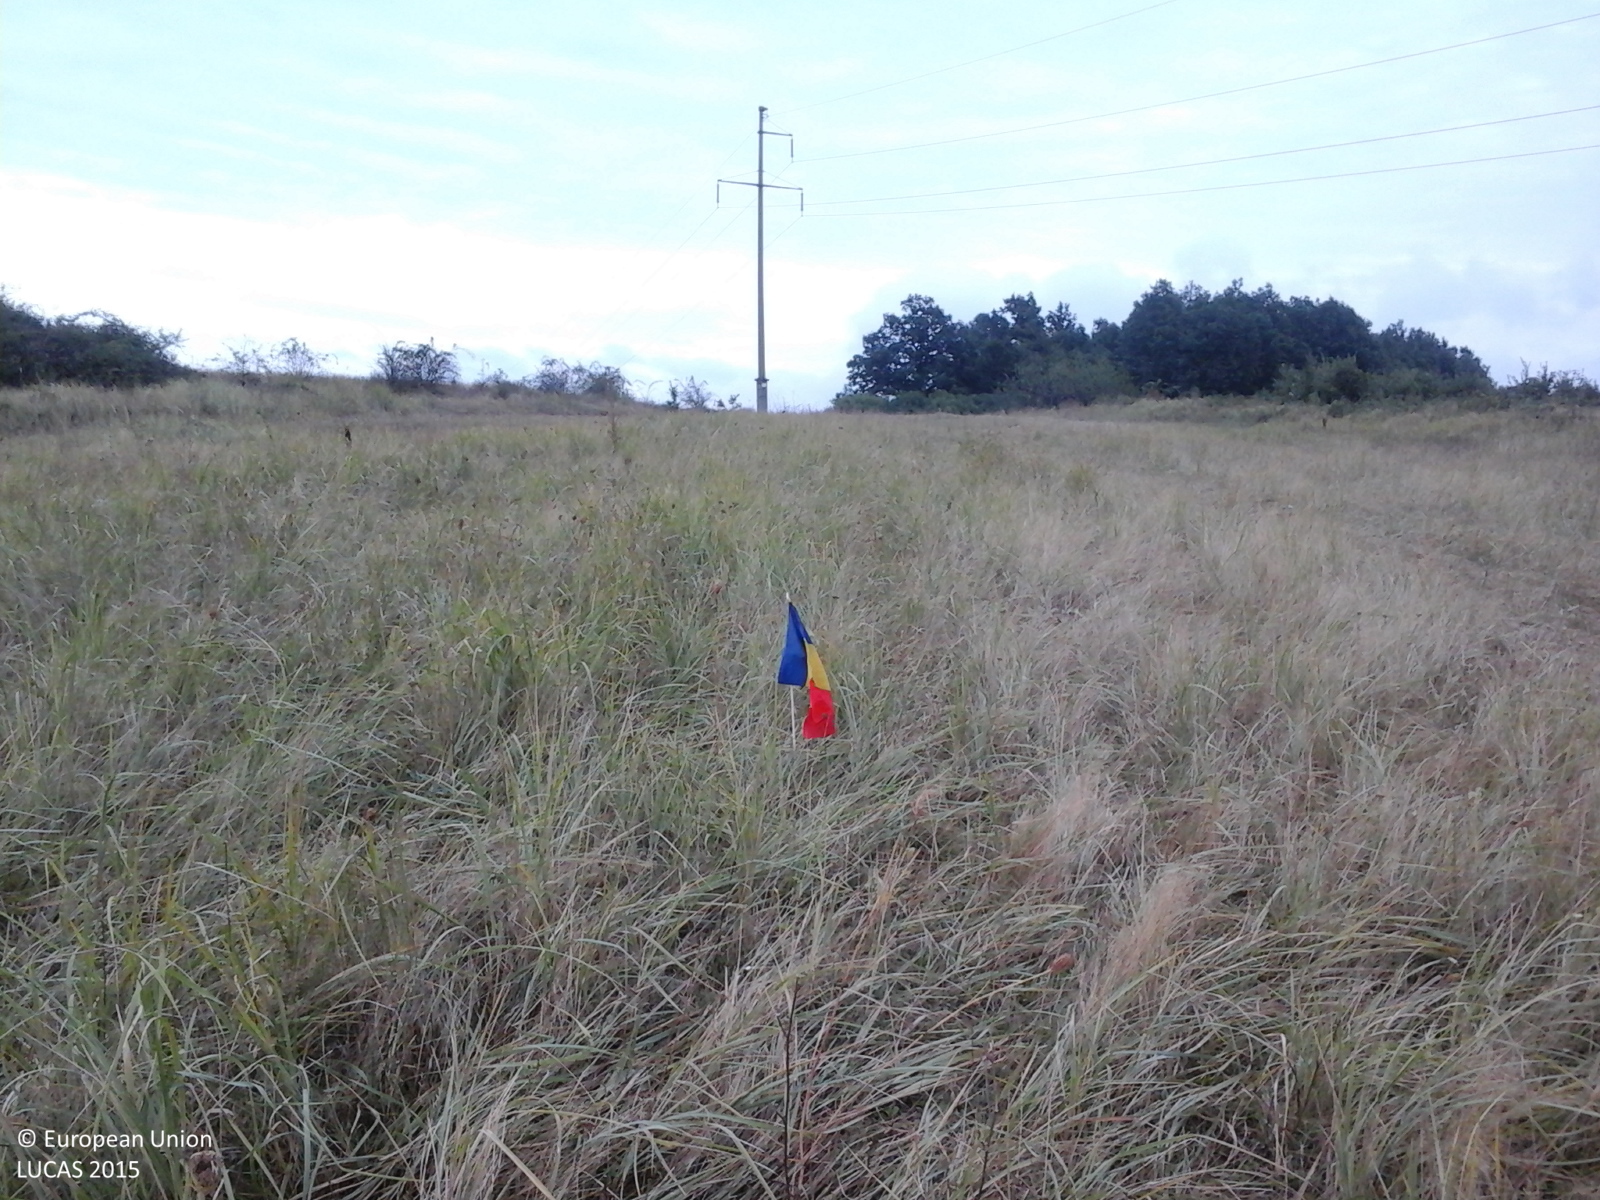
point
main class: Grassland
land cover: Grassland with sparse tree/shrub cover
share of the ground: > 75 %
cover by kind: herbaceous plants 85 %, shrubs 10 %, broadleaved forest trees 5 %
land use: Agriculture (excluding fallow land and kitchen gardens)
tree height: < 5 m
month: September
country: RO
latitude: 47.2169
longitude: 22.3466
